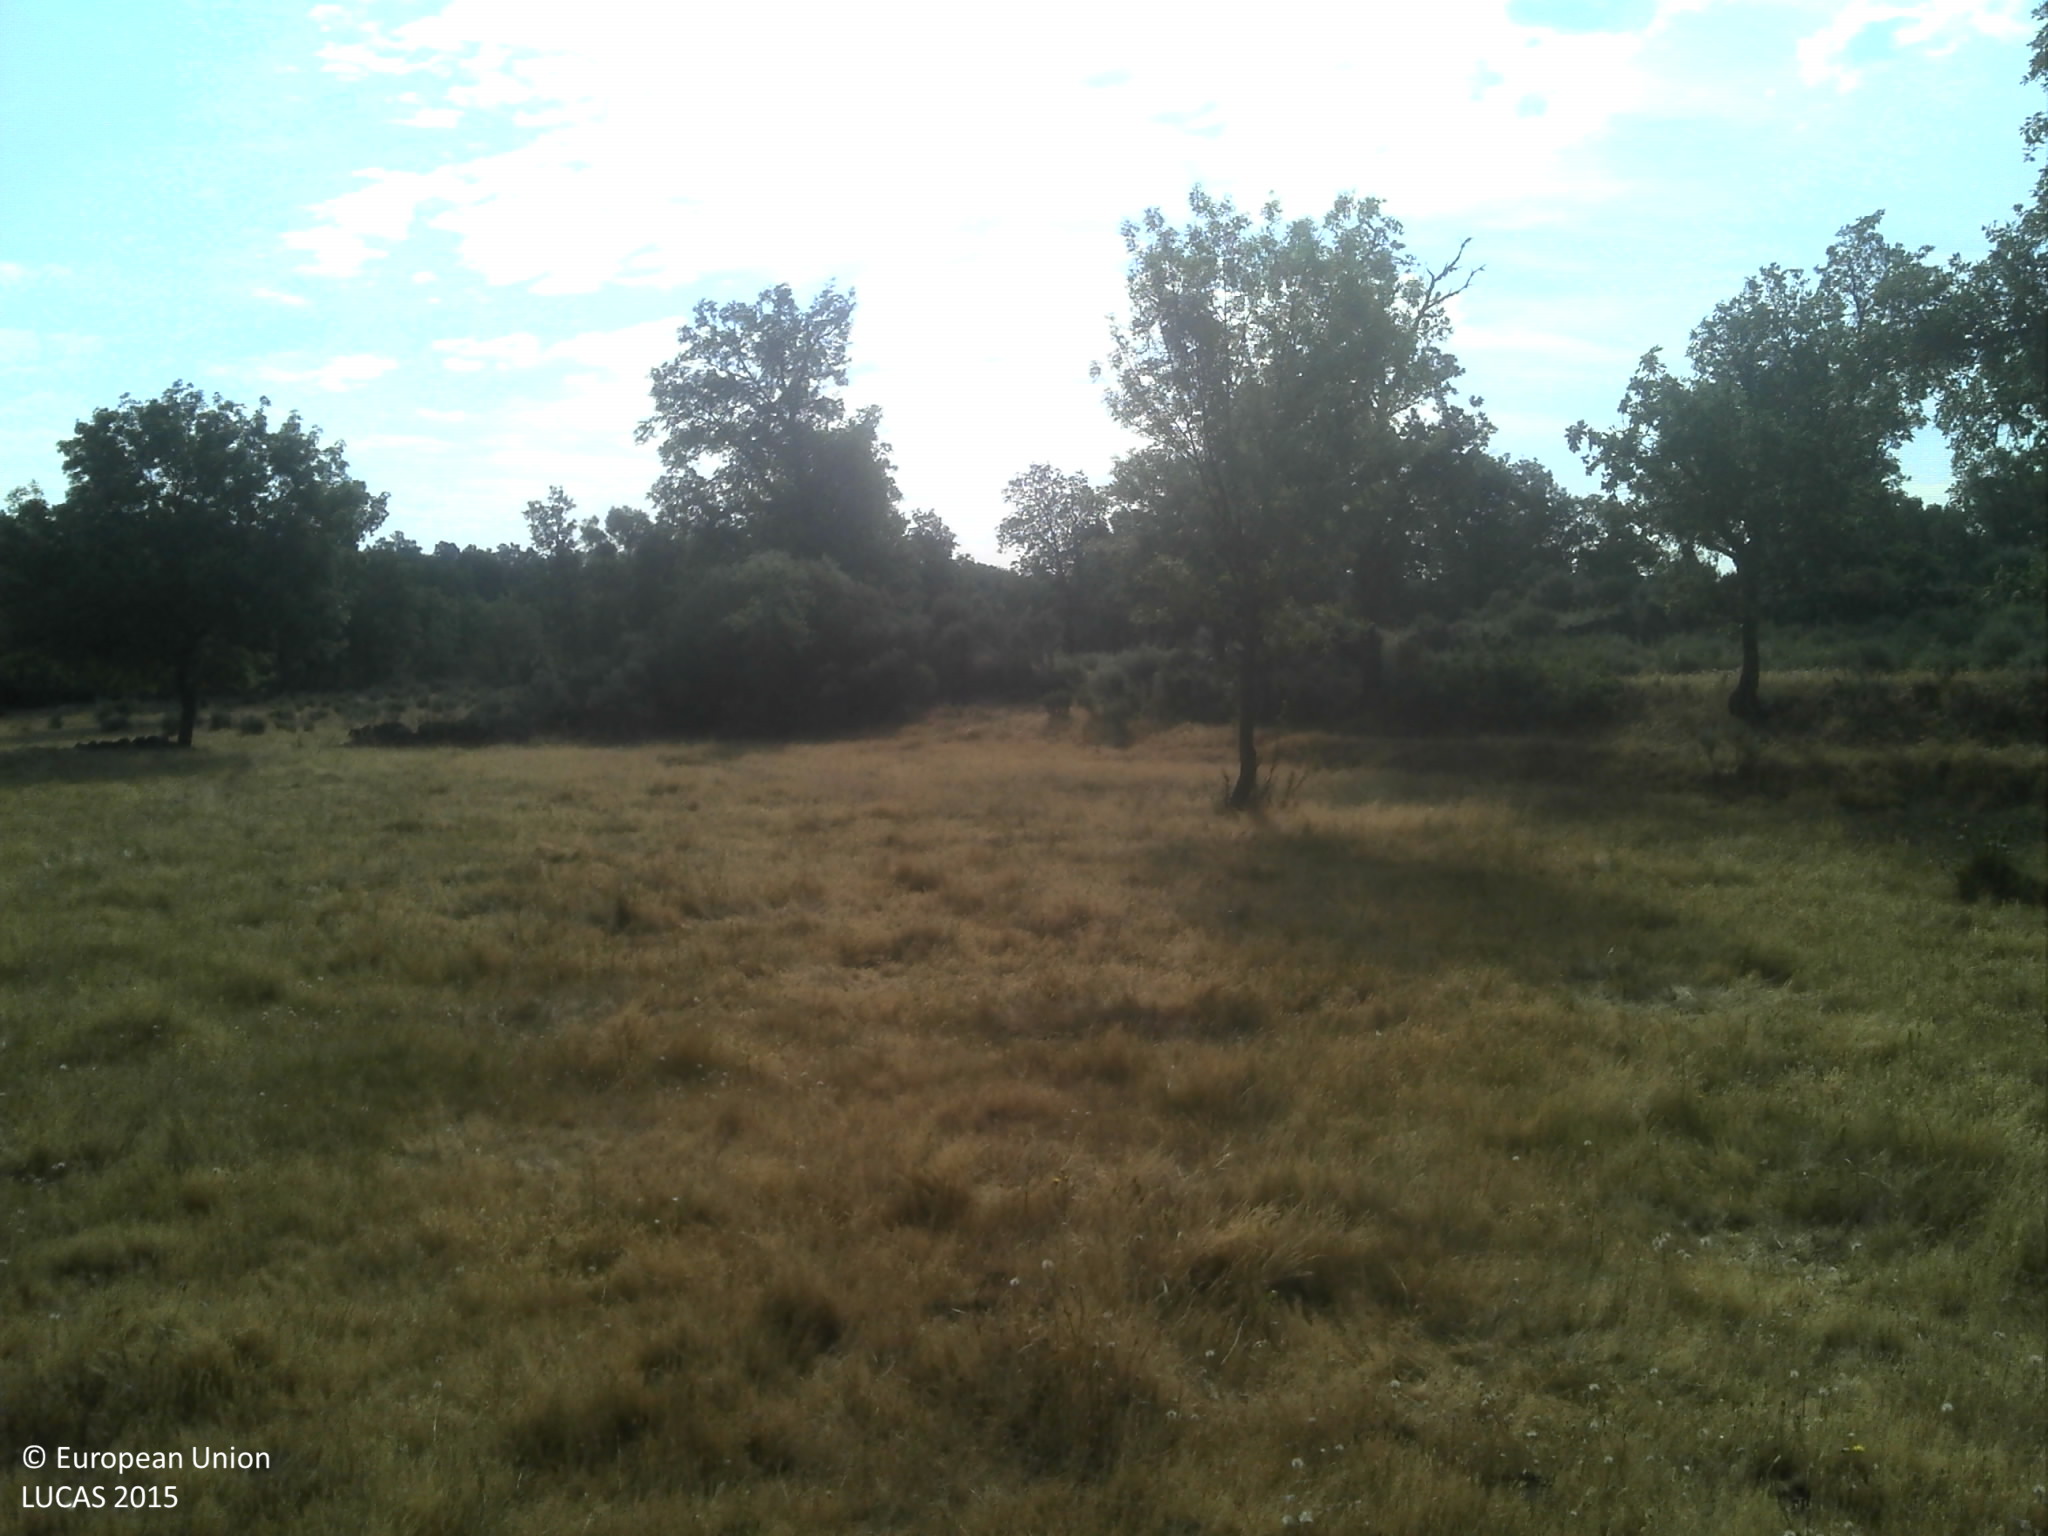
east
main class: Grassland
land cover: Grassland without tree/shrub cover
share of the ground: 50 - 75 %
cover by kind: herbaceous plants 75 %, unconsolidated bare surface 25 %
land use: Agriculture (excluding fallow land and kitchen gardens)
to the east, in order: Grassland without tree/shrub cover; Dry stone walls; Grassland without tree/shrub cover; Dry stone walls; Lines of trees; Grassland without tree/shrub cover; Dry stone walls; Grassland without tree/shrub cover; Fences; Dry stone walls; Broadleaved woodland; Dry stone walls; Lines of trees; Grassland without tree/shrub cover
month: June
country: PT
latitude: 40.4149
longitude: -6.9848
